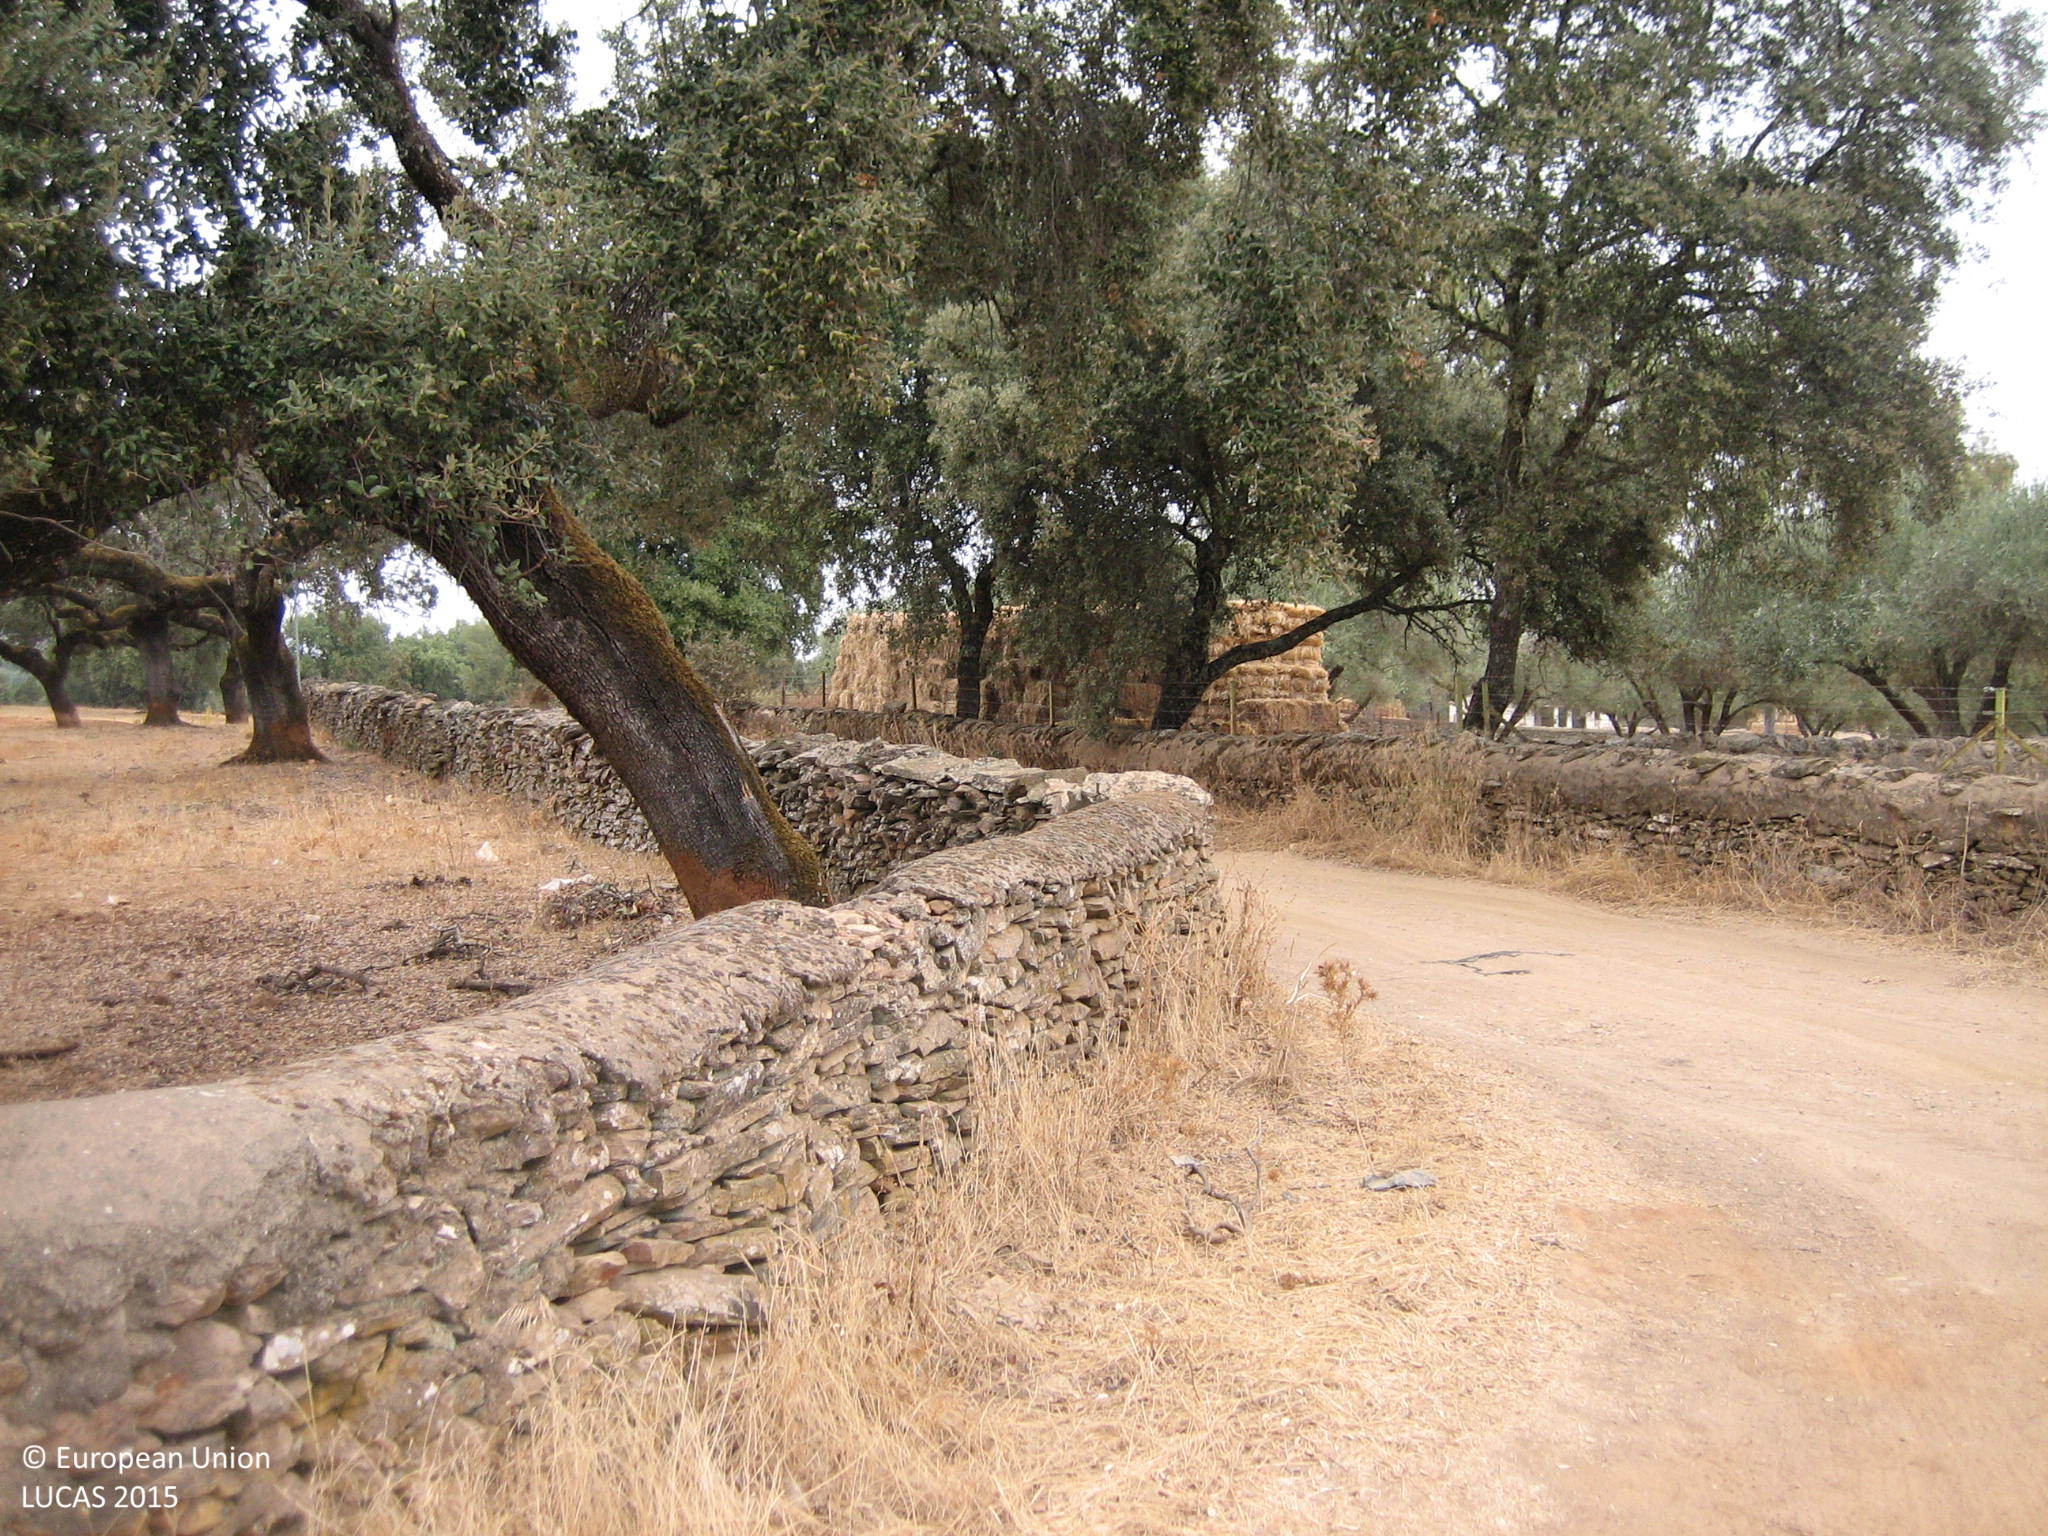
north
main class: Woodland
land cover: Broadleaved woodland
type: broadleaved evergreen forest
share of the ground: > 75 %
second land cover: Grassland without tree/shrub cover
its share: > 75 %
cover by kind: broadleaved forest trees 85 %, herbaceous plants 15 %
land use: Forestry
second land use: Agriculture (excluding fallow land and kitchen gardens)
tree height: > 5 m
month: September
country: ES
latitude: 38.3170
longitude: -6.8587
